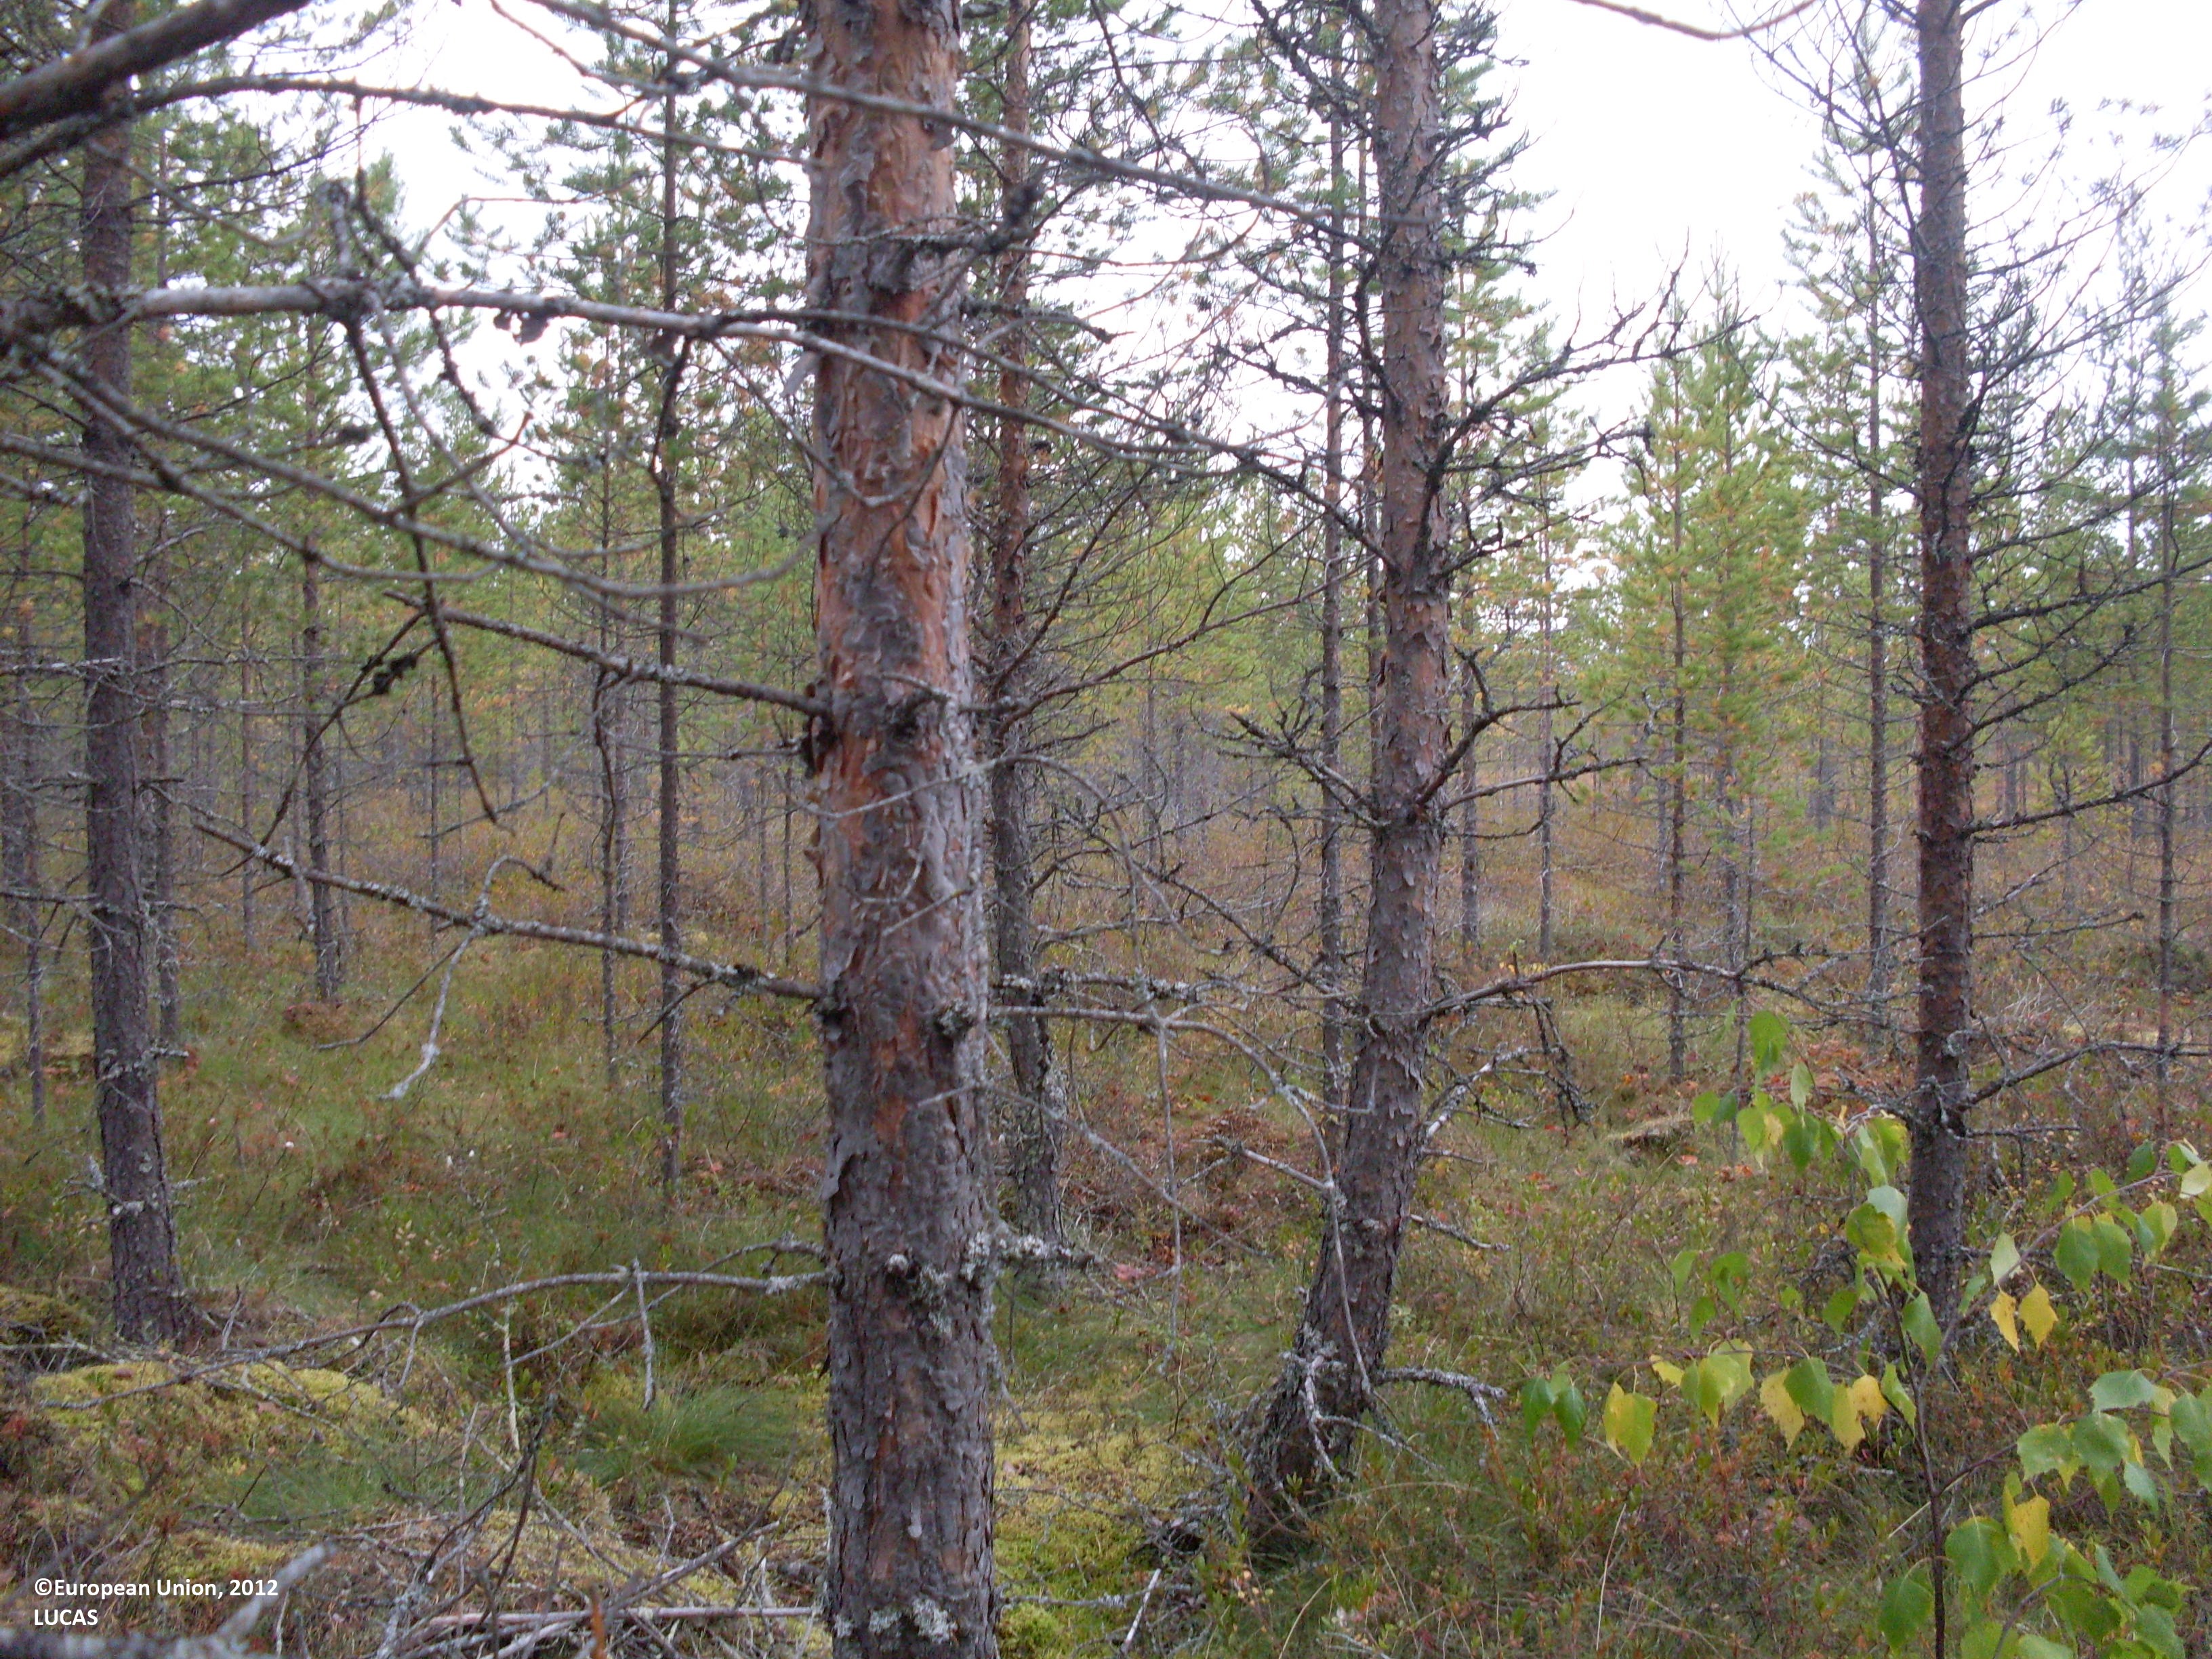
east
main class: Woodland
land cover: Pine dominated coniferous woodland
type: boreal forest
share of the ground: 50 - 75 %
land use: Forestry
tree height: > 5 m
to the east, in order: Pine dominated coniferous woodland; Peatbogs
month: September
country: FI
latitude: 64.1504
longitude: 29.4360
